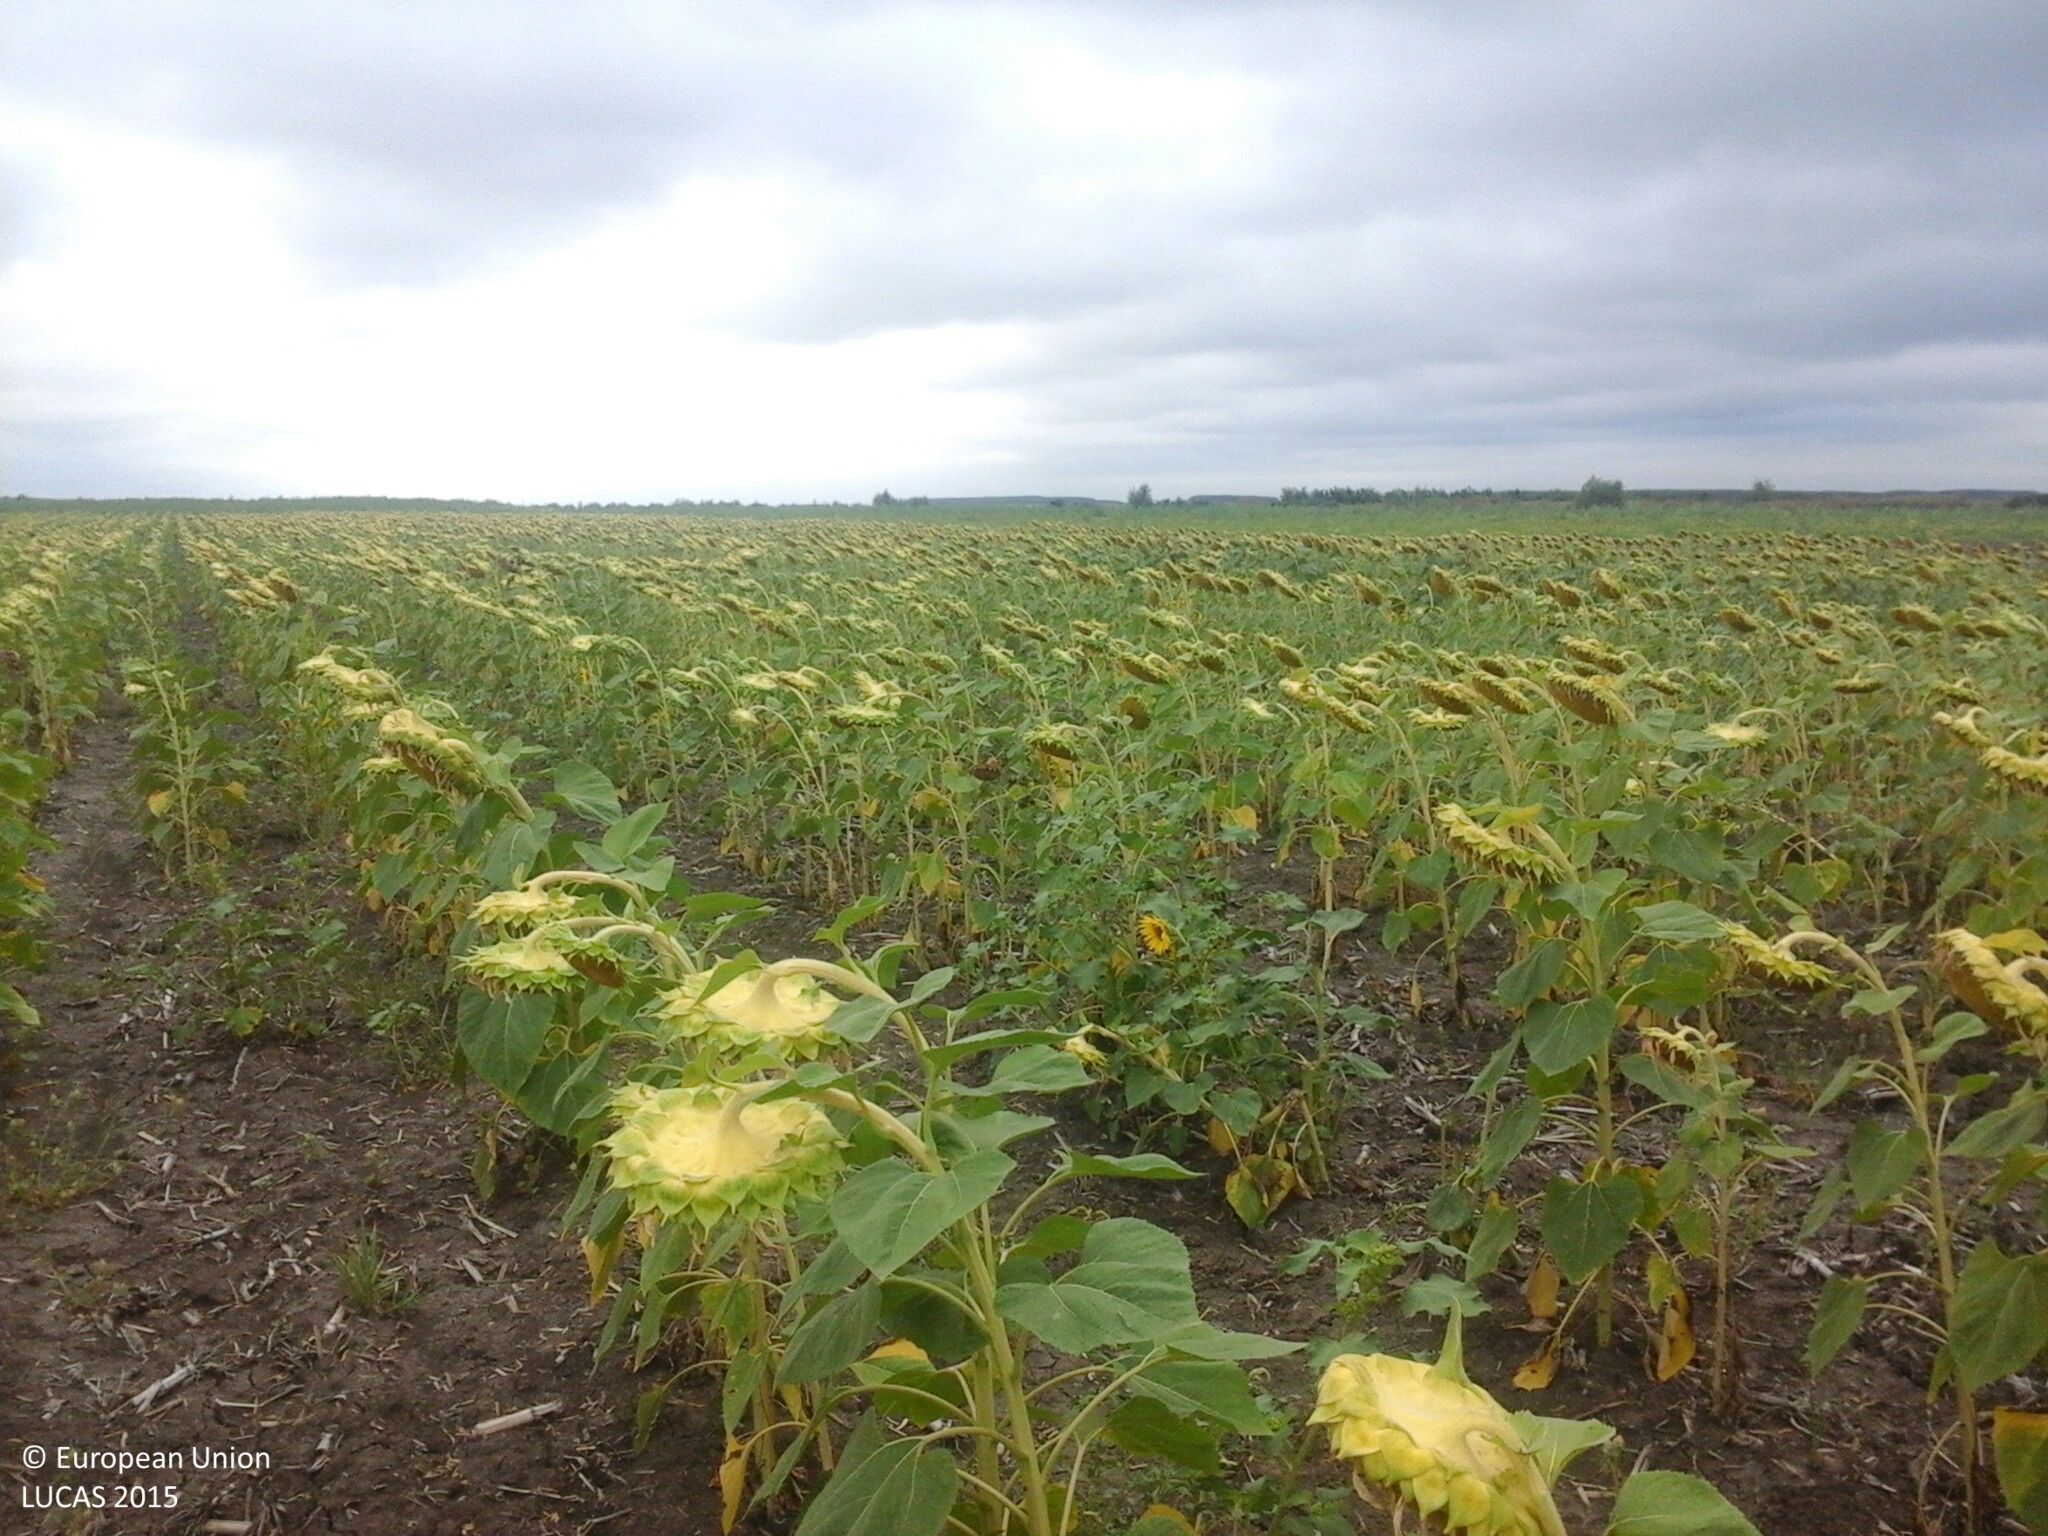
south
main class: Cropland
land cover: Sunflower
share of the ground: 50 - 75 %
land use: Agriculture (excluding fallow land and kitchen gardens)
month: August
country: HU
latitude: 47.0170
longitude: 21.5253
